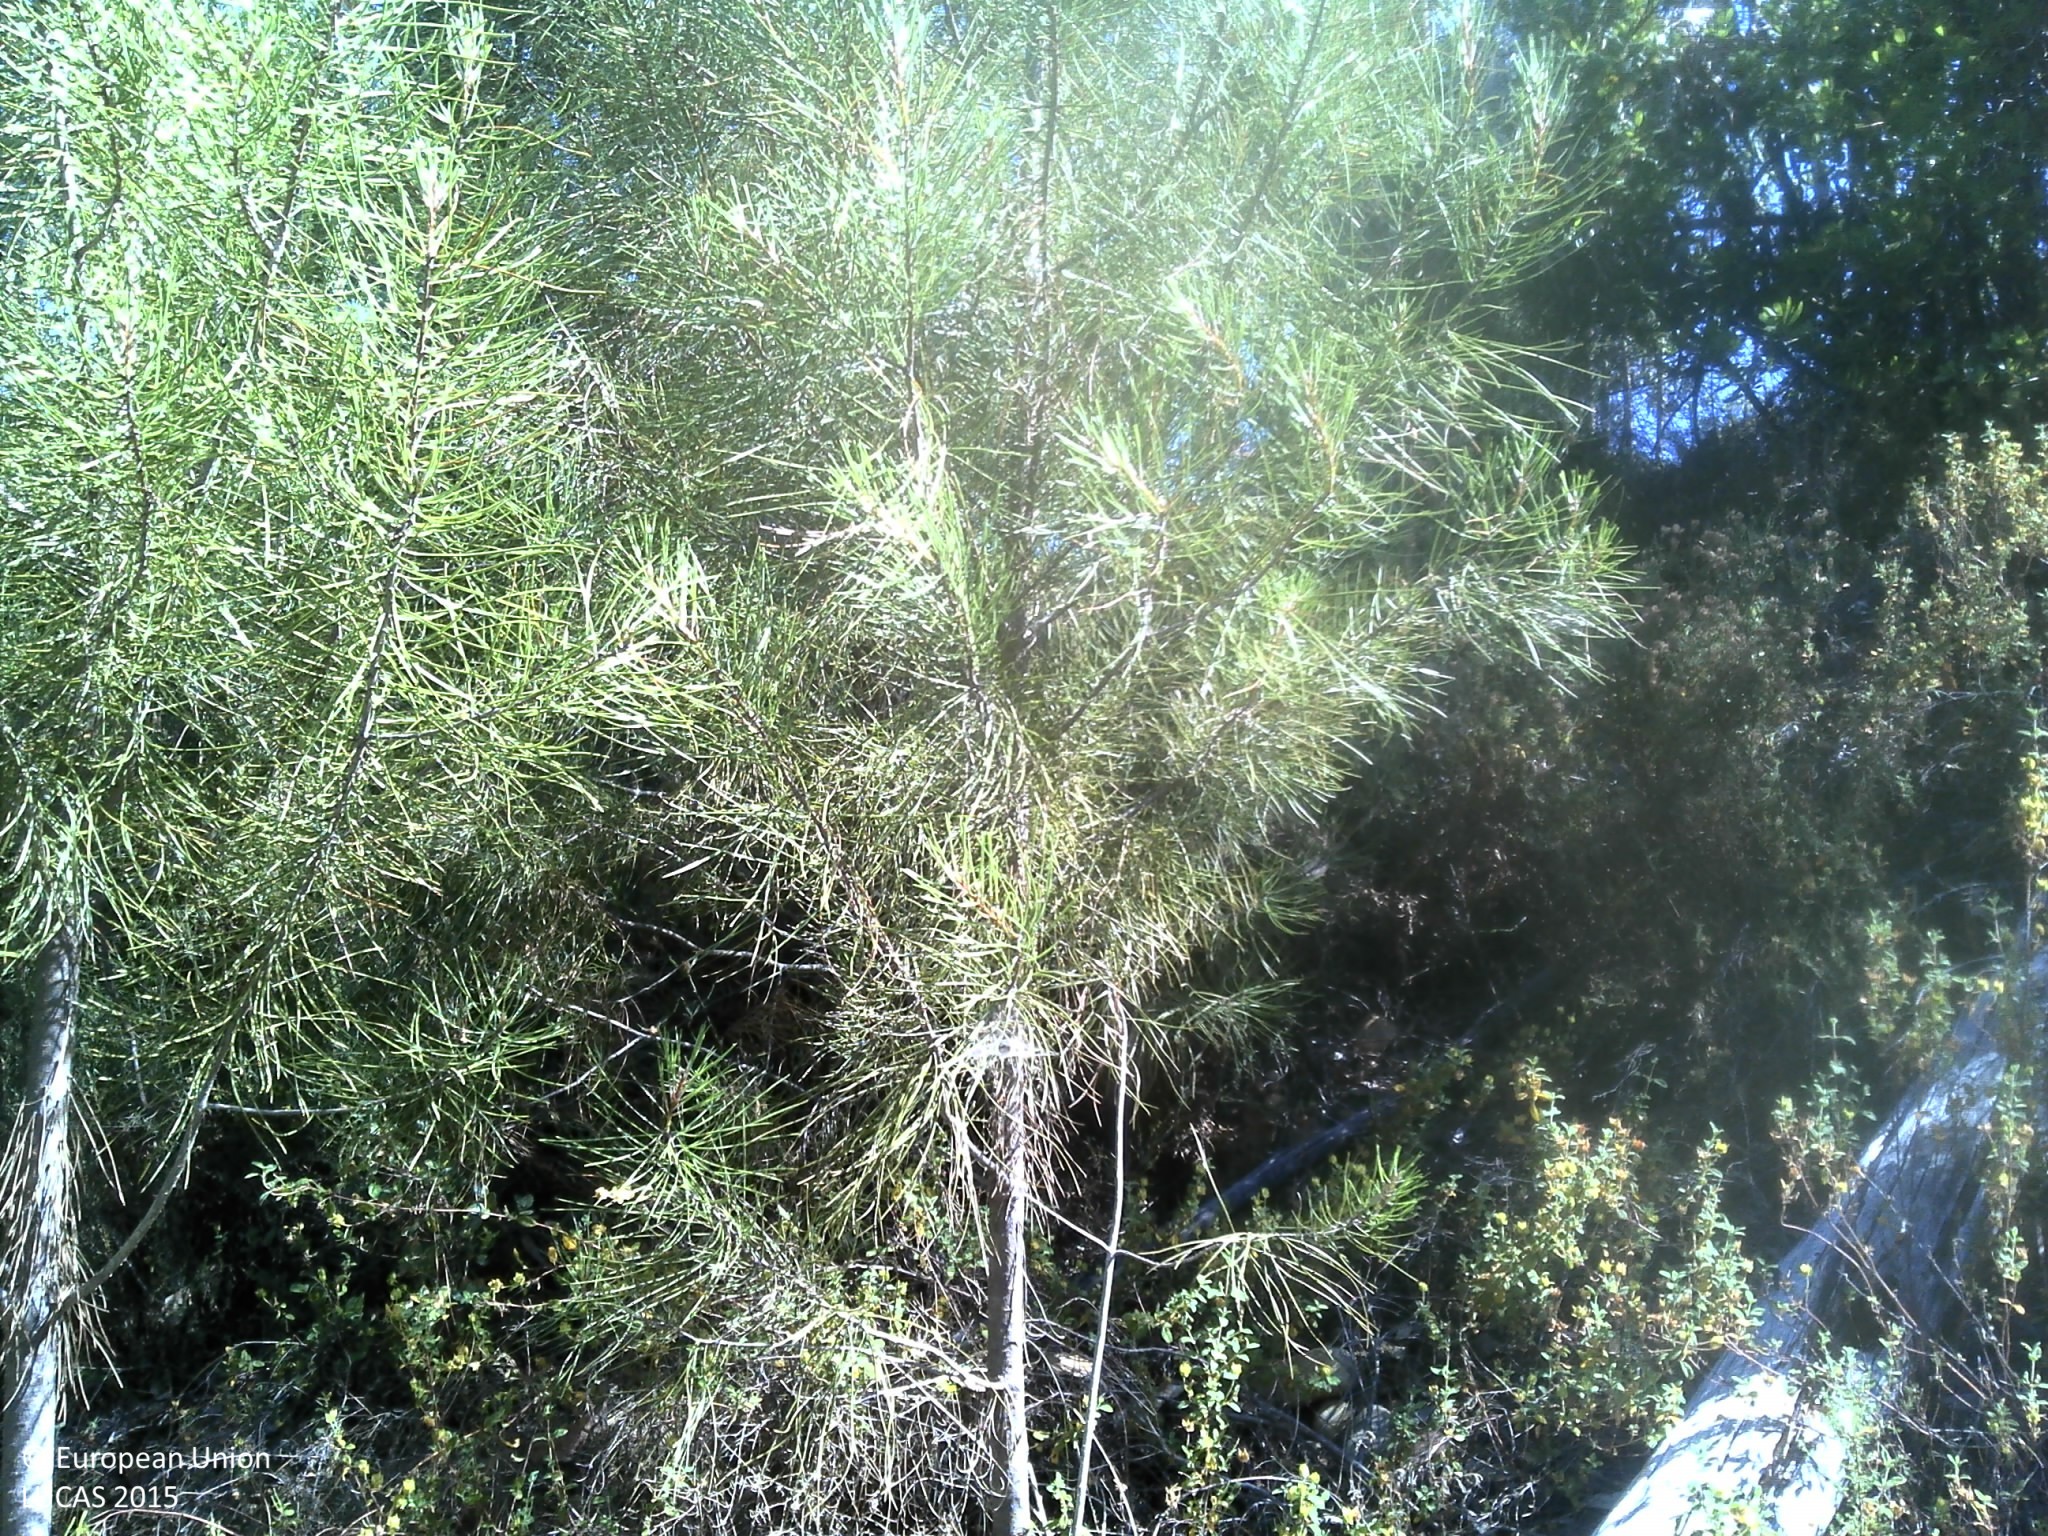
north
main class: Woodland
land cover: Pine dominated mixed woodland
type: coniferous forest of the mediterranean region
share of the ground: 25 - 50 %
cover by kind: coniferous forest trees 50 %, broadleaved forest trees 20 %, shrubs 15 %, unconsolidated bare surface 10 %, herbaceous plants 5 %
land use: Forestry
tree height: > 5 m
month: May
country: PT
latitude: 39.3449
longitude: -8.3880
